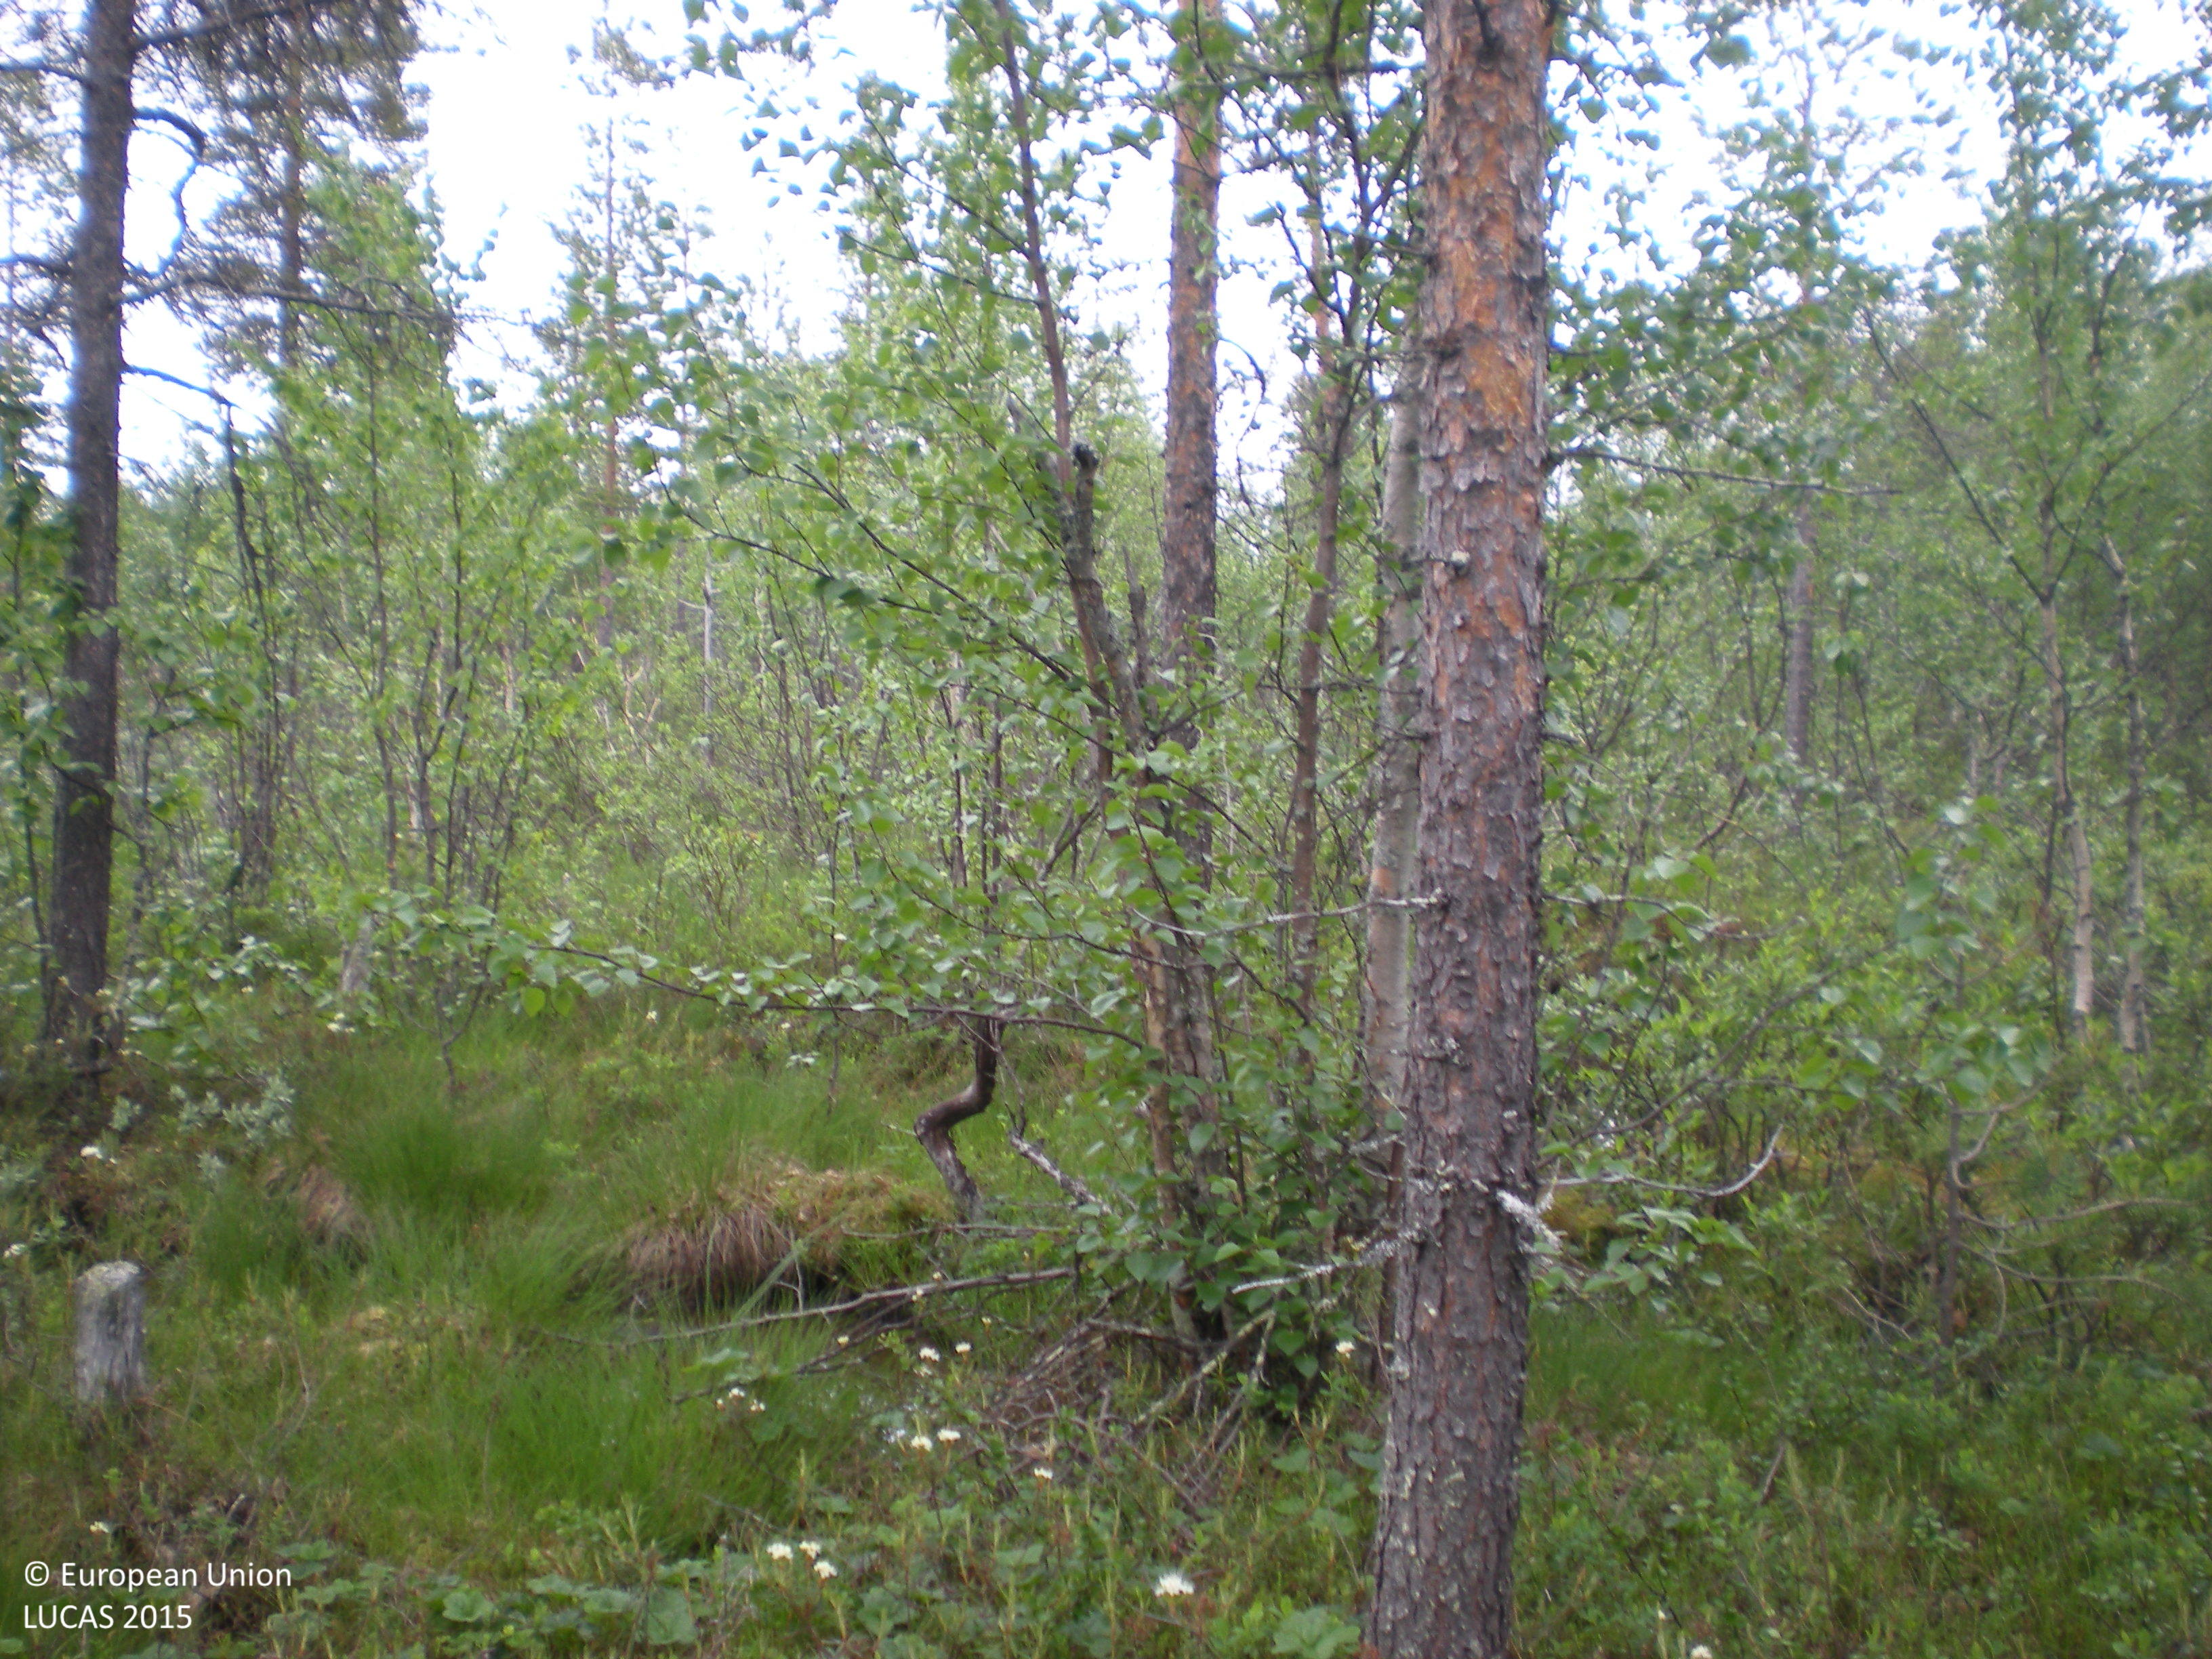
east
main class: Woodland
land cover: Pine dominated mixed woodland
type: mire and swamp forests
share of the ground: 25 - 50 %
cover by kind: broadleaved forest trees 30 %, coniferous forest trees 25 %, shrubs 20 %, herbaceous plants 15 %, lichens and mosses 5 %
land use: Forestry
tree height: < 5 m
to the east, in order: Pine dominated mixed woodland; Peatbogs; Pine dominated coniferous woodland
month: July
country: SE
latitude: 66.1337
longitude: 17.3751
